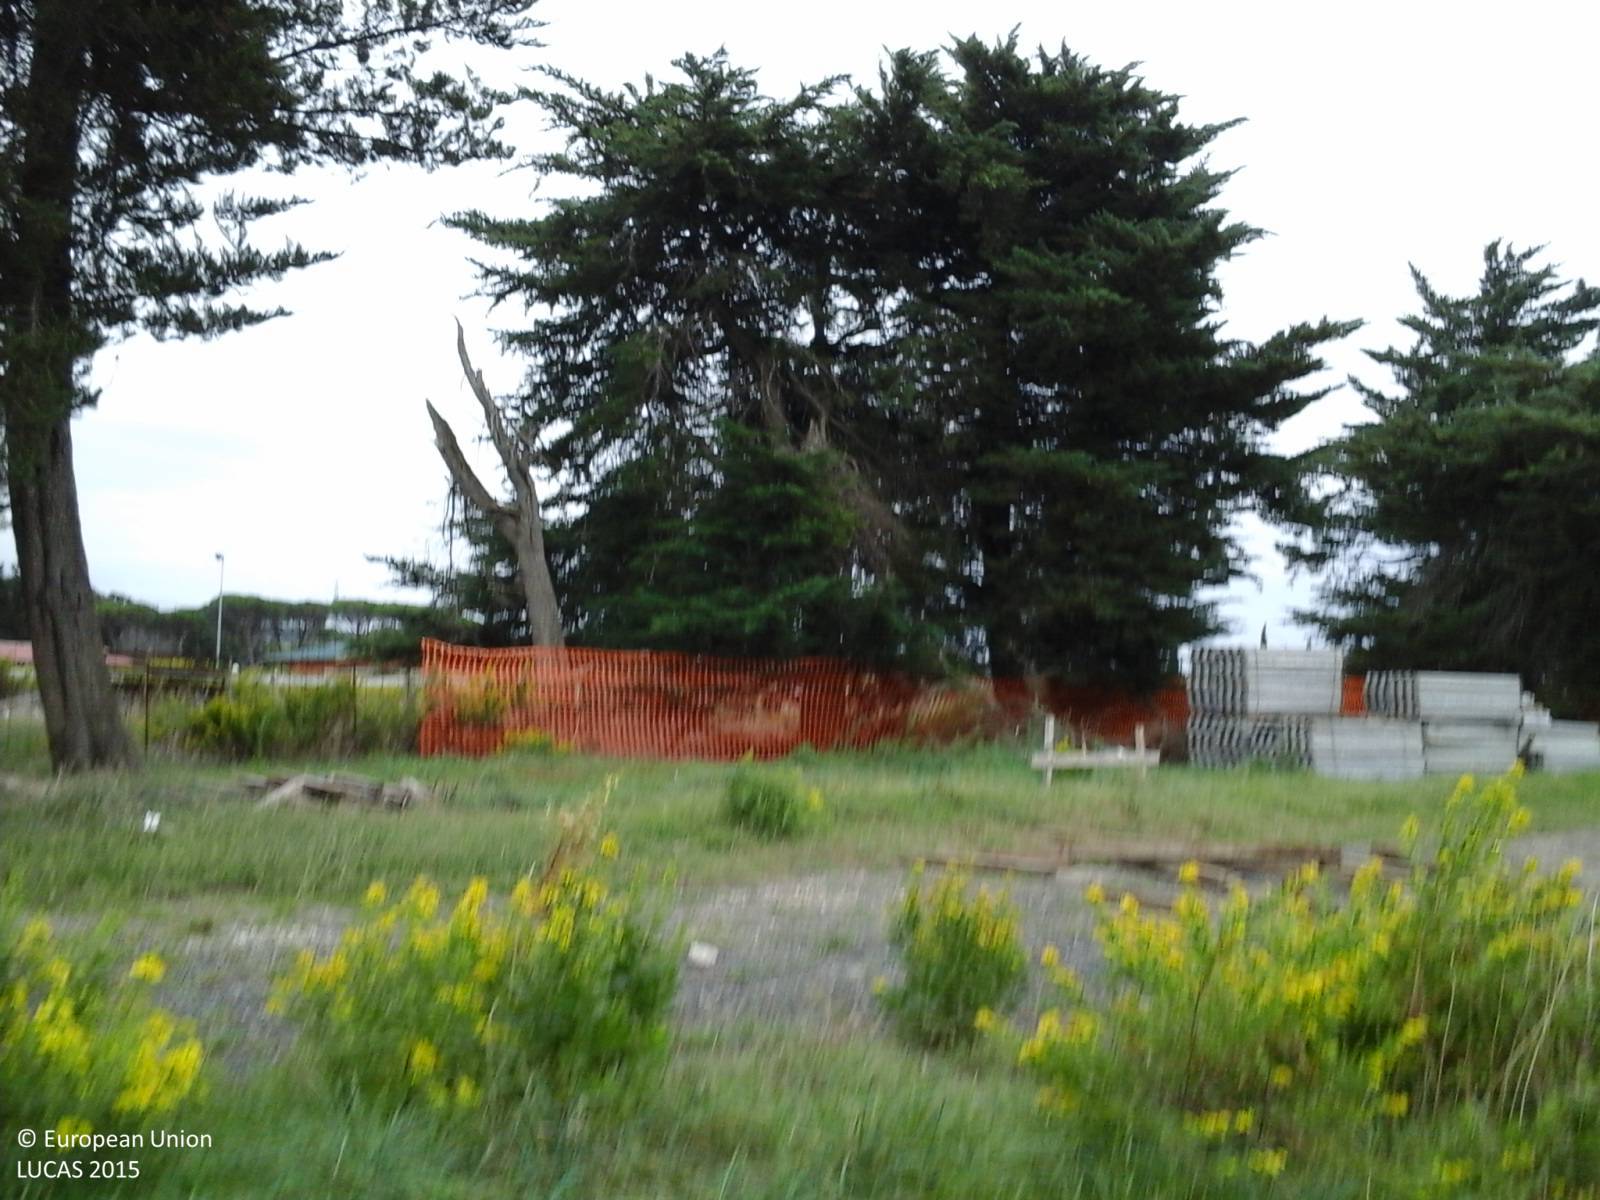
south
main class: Grassland
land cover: Spontaneously vegetated surfaces
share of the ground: 50 - 75 %
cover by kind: herbaceous plants 100 %
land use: Construction
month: October
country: IT
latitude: 43.5561
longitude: 10.3580
